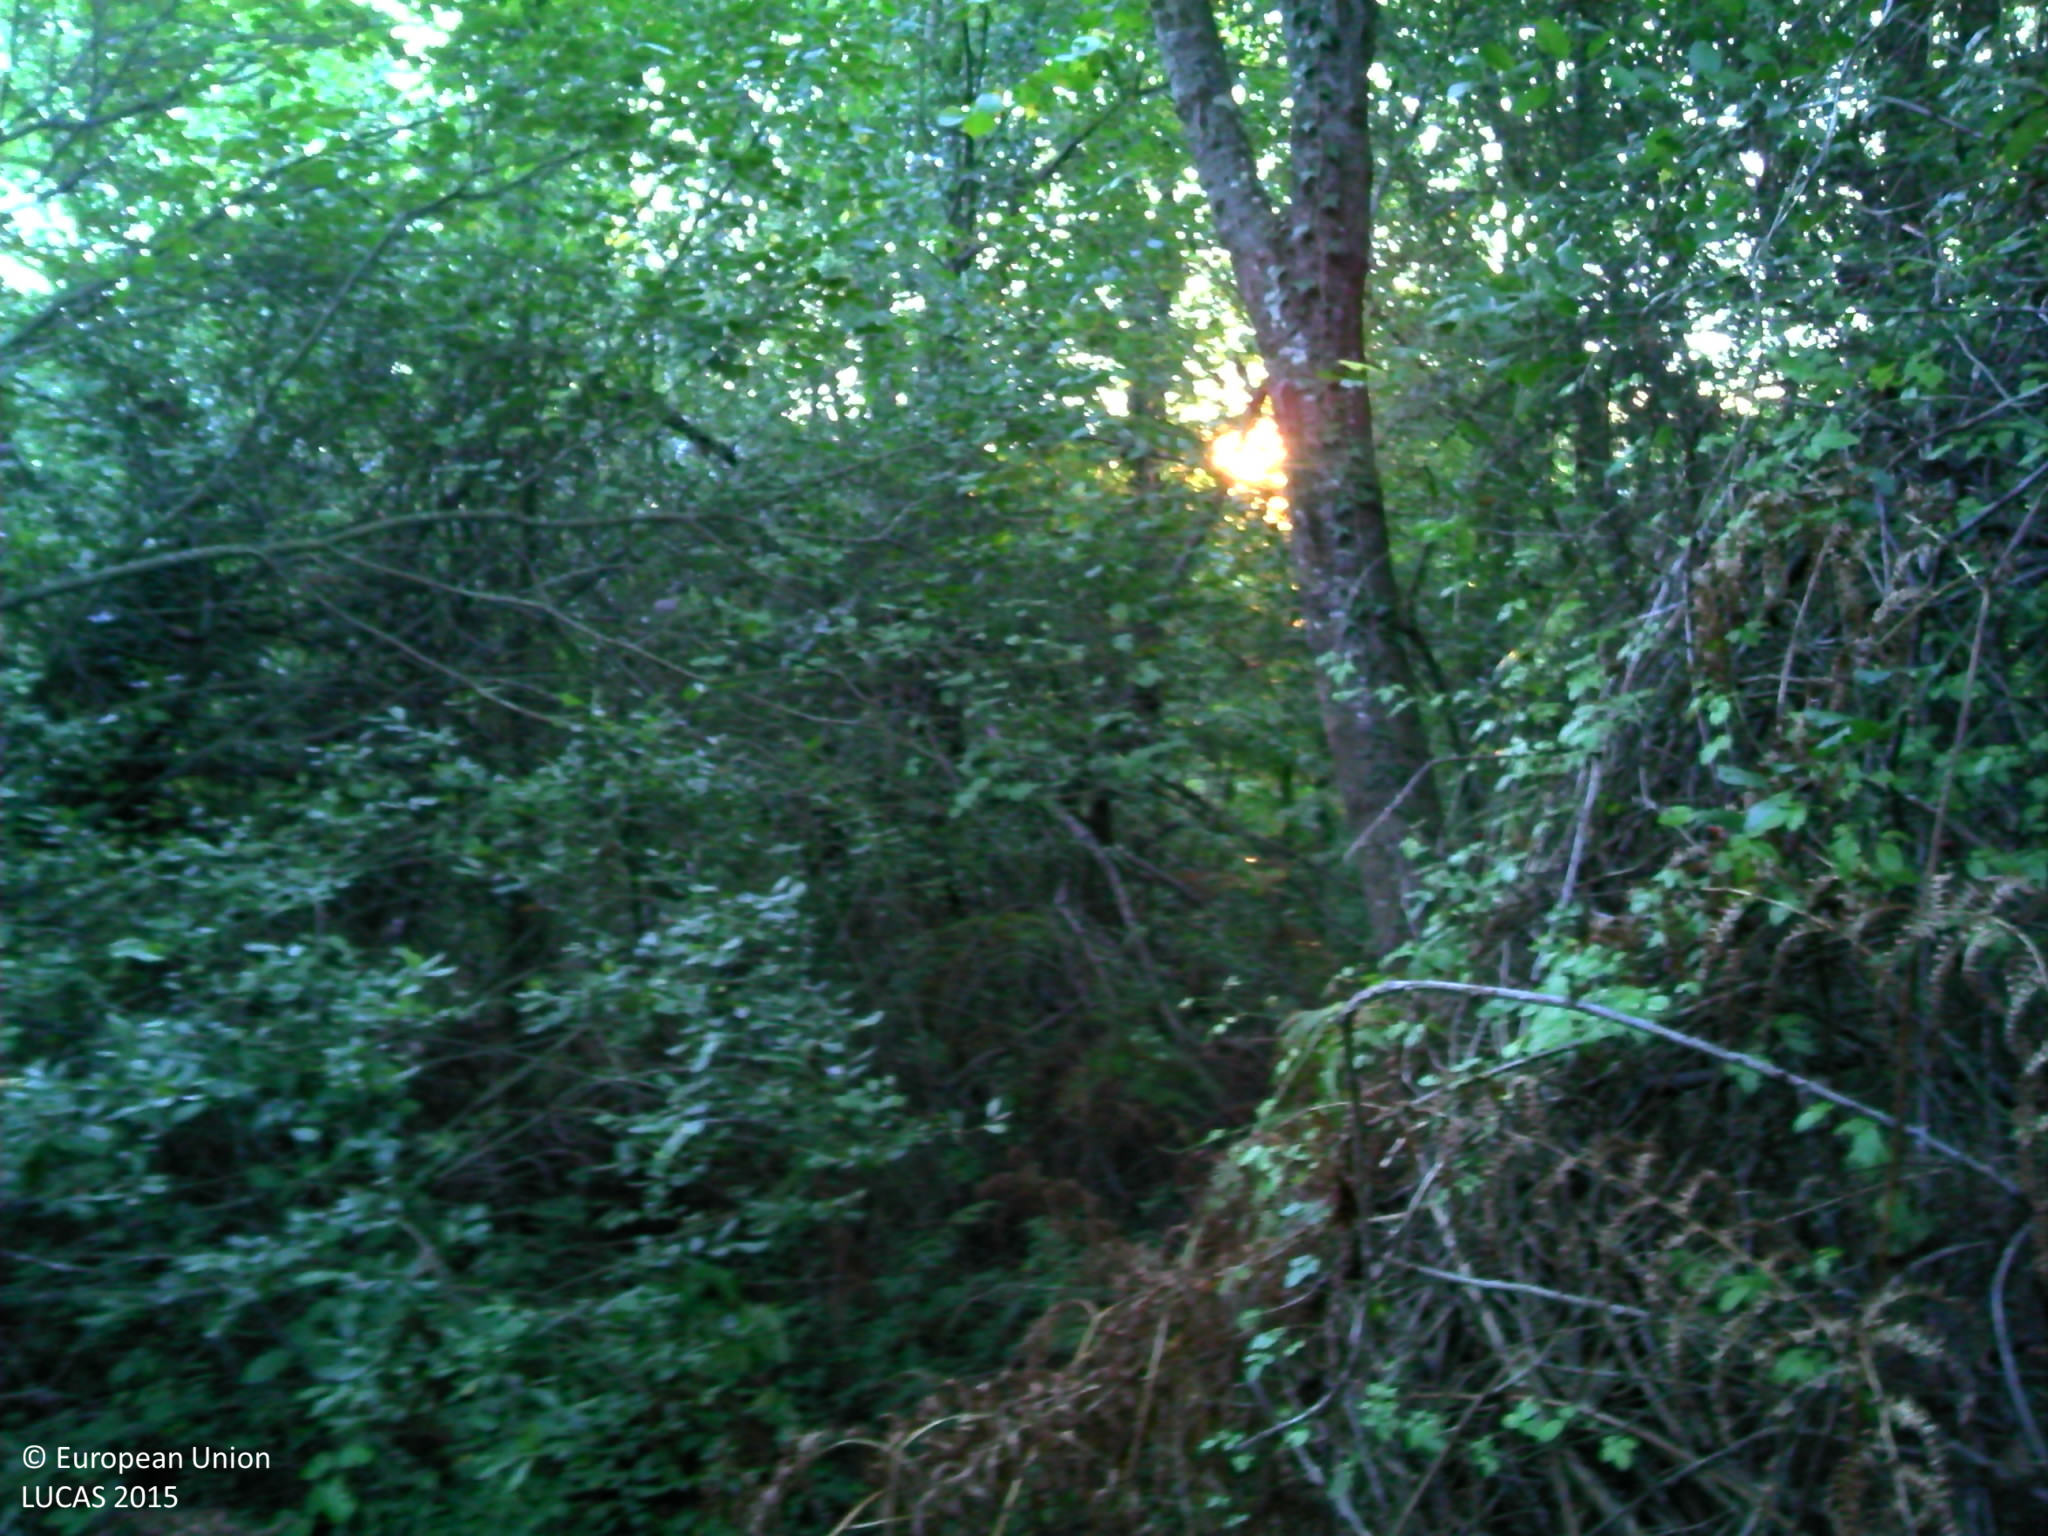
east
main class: Woodland
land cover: Broadleaved woodland
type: beech forest
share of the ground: > 75 %
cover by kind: broadleaved forest trees 80 %, shrubs 10 %, herbaceous plants 10 %
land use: Forestry
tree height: > 5 m
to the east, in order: Broadleaved woodland; Grass margins; Tracks; Grass margins; Broadleaved woodland; Tracks; Broadleaved woodland
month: September
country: FR
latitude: 43.1775
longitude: -0.6992
